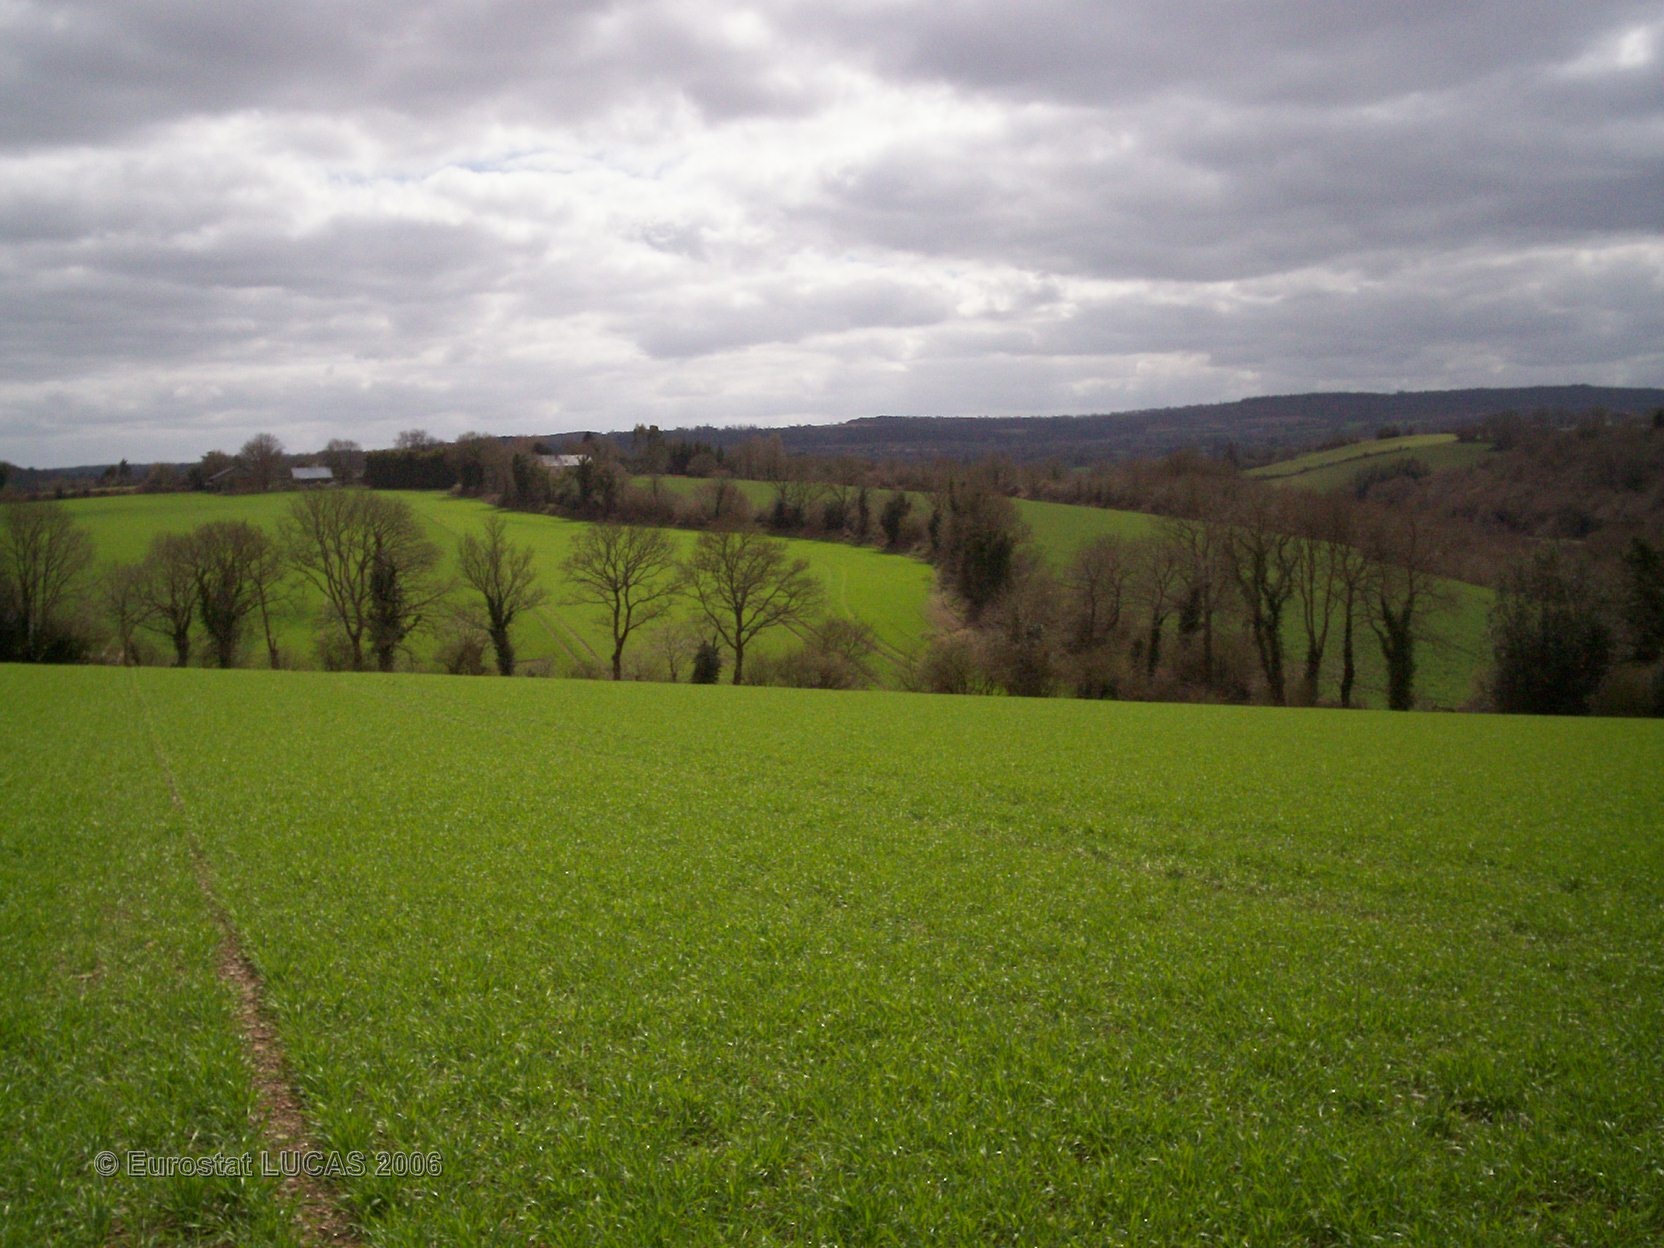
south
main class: Cropland
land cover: Common wheat
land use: Agriculture (excluding fallow land and kitchen gardens)
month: April
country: FR
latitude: 48.2178
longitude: -3.5788
